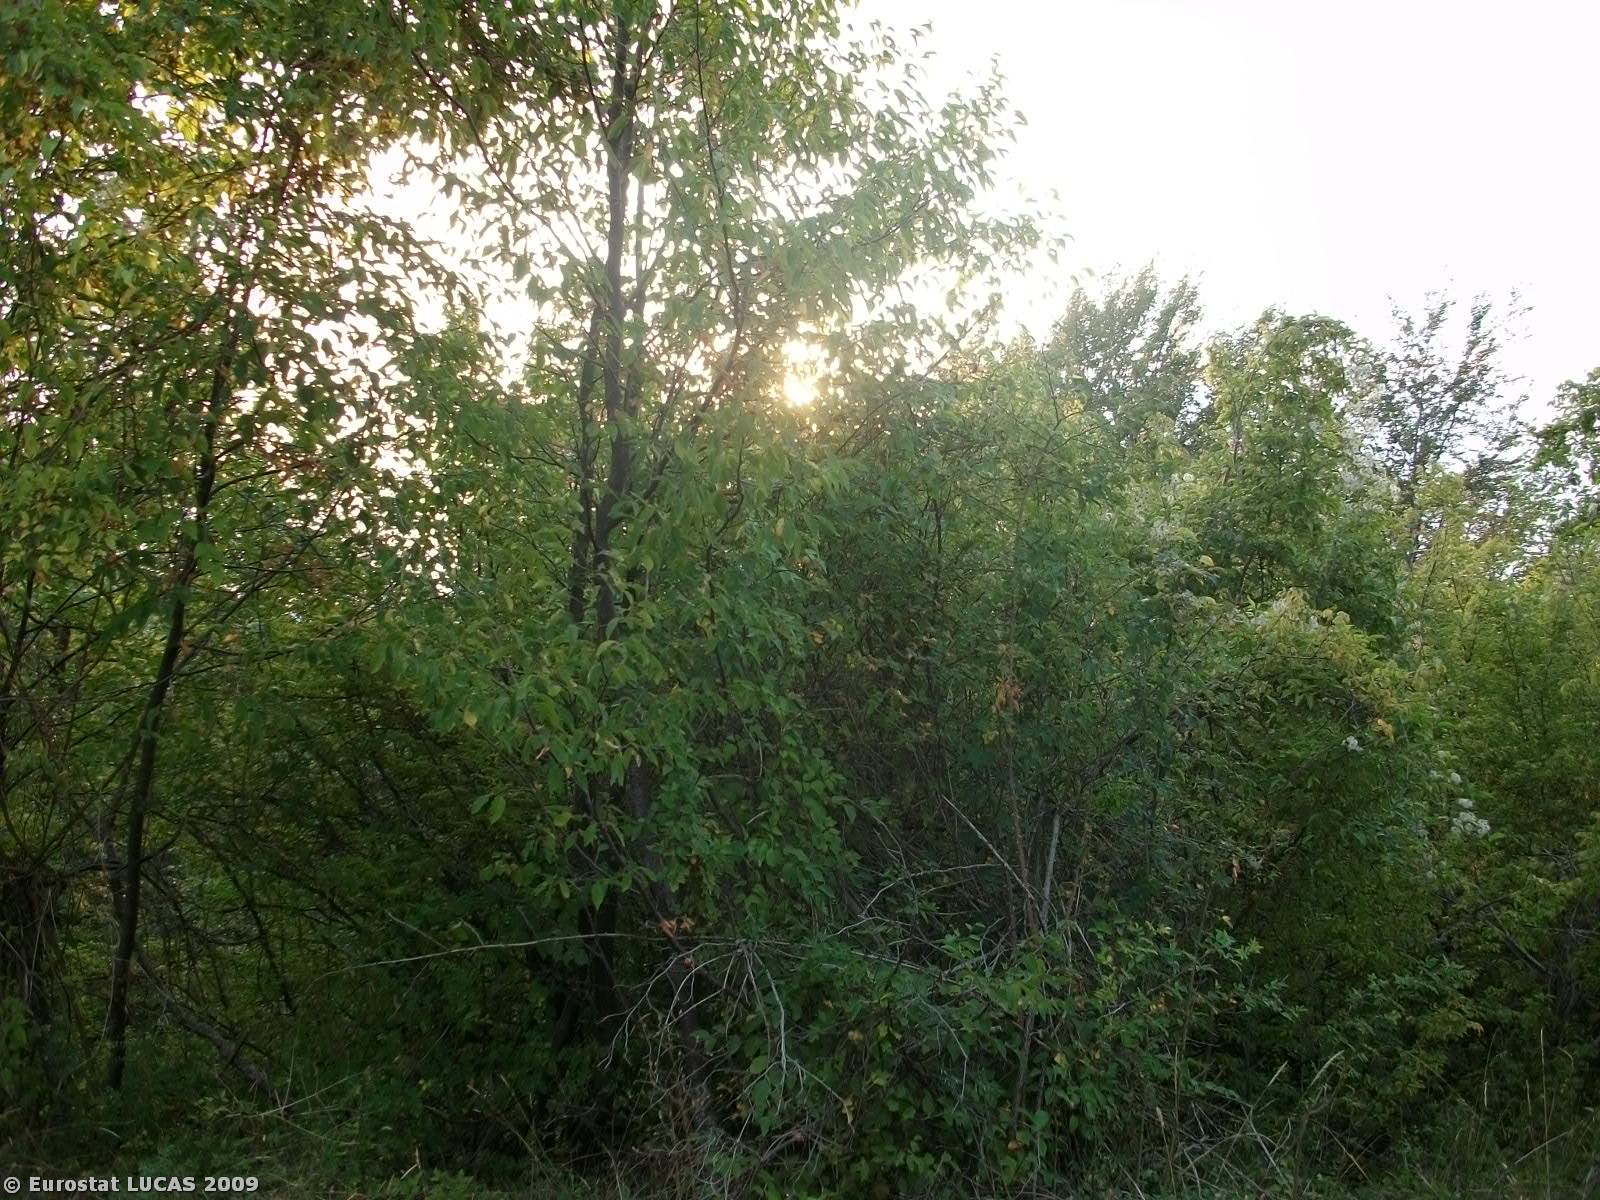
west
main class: Woodland
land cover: Broadleaved woodland
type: broadleaved evergreen forest
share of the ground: > 75 %
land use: Forestry
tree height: > 5 m
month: September
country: GR
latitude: 41.1514
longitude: 24.4645
